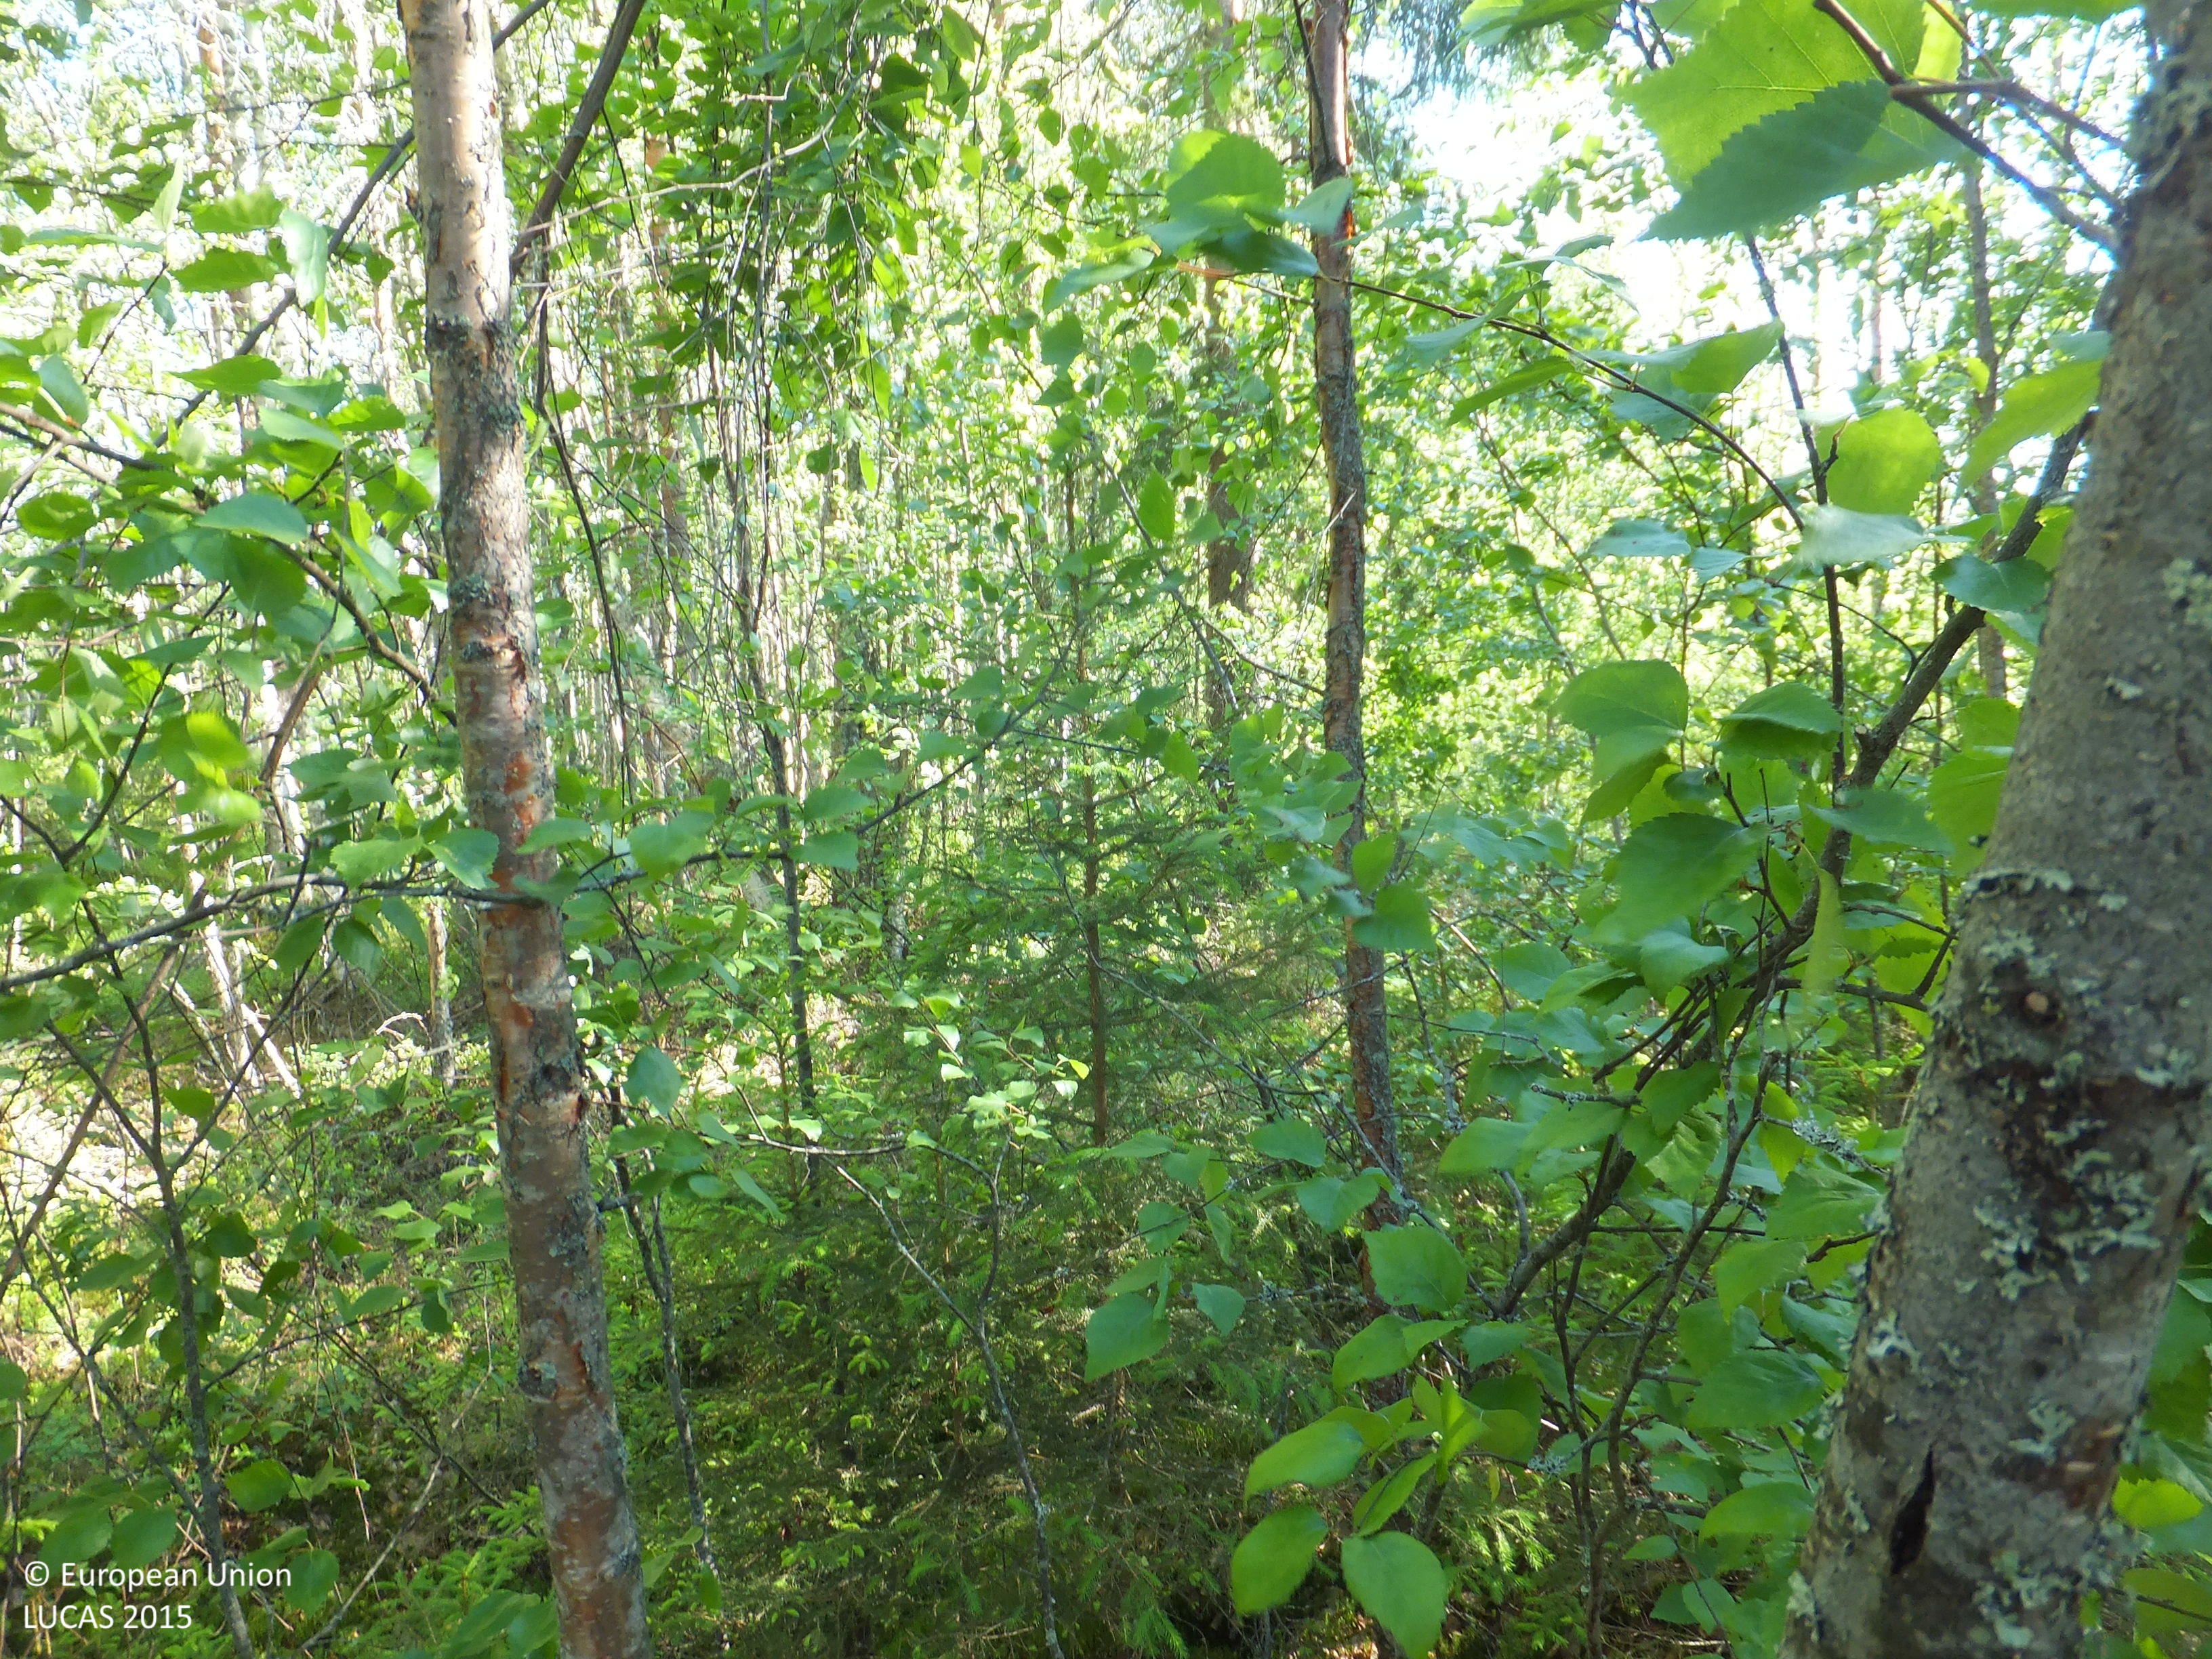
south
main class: Woodland
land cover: Other mixed woodland
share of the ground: 50 - 75 %
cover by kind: coniferous forest trees 30 %, broadleaved forest trees 30 %, shrubs 25 %, lichens and mosses 10 %, herbaceous plants 5 %
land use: Forestry
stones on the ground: < 10 %
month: June
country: FI
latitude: 63.2936
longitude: 24.2169
